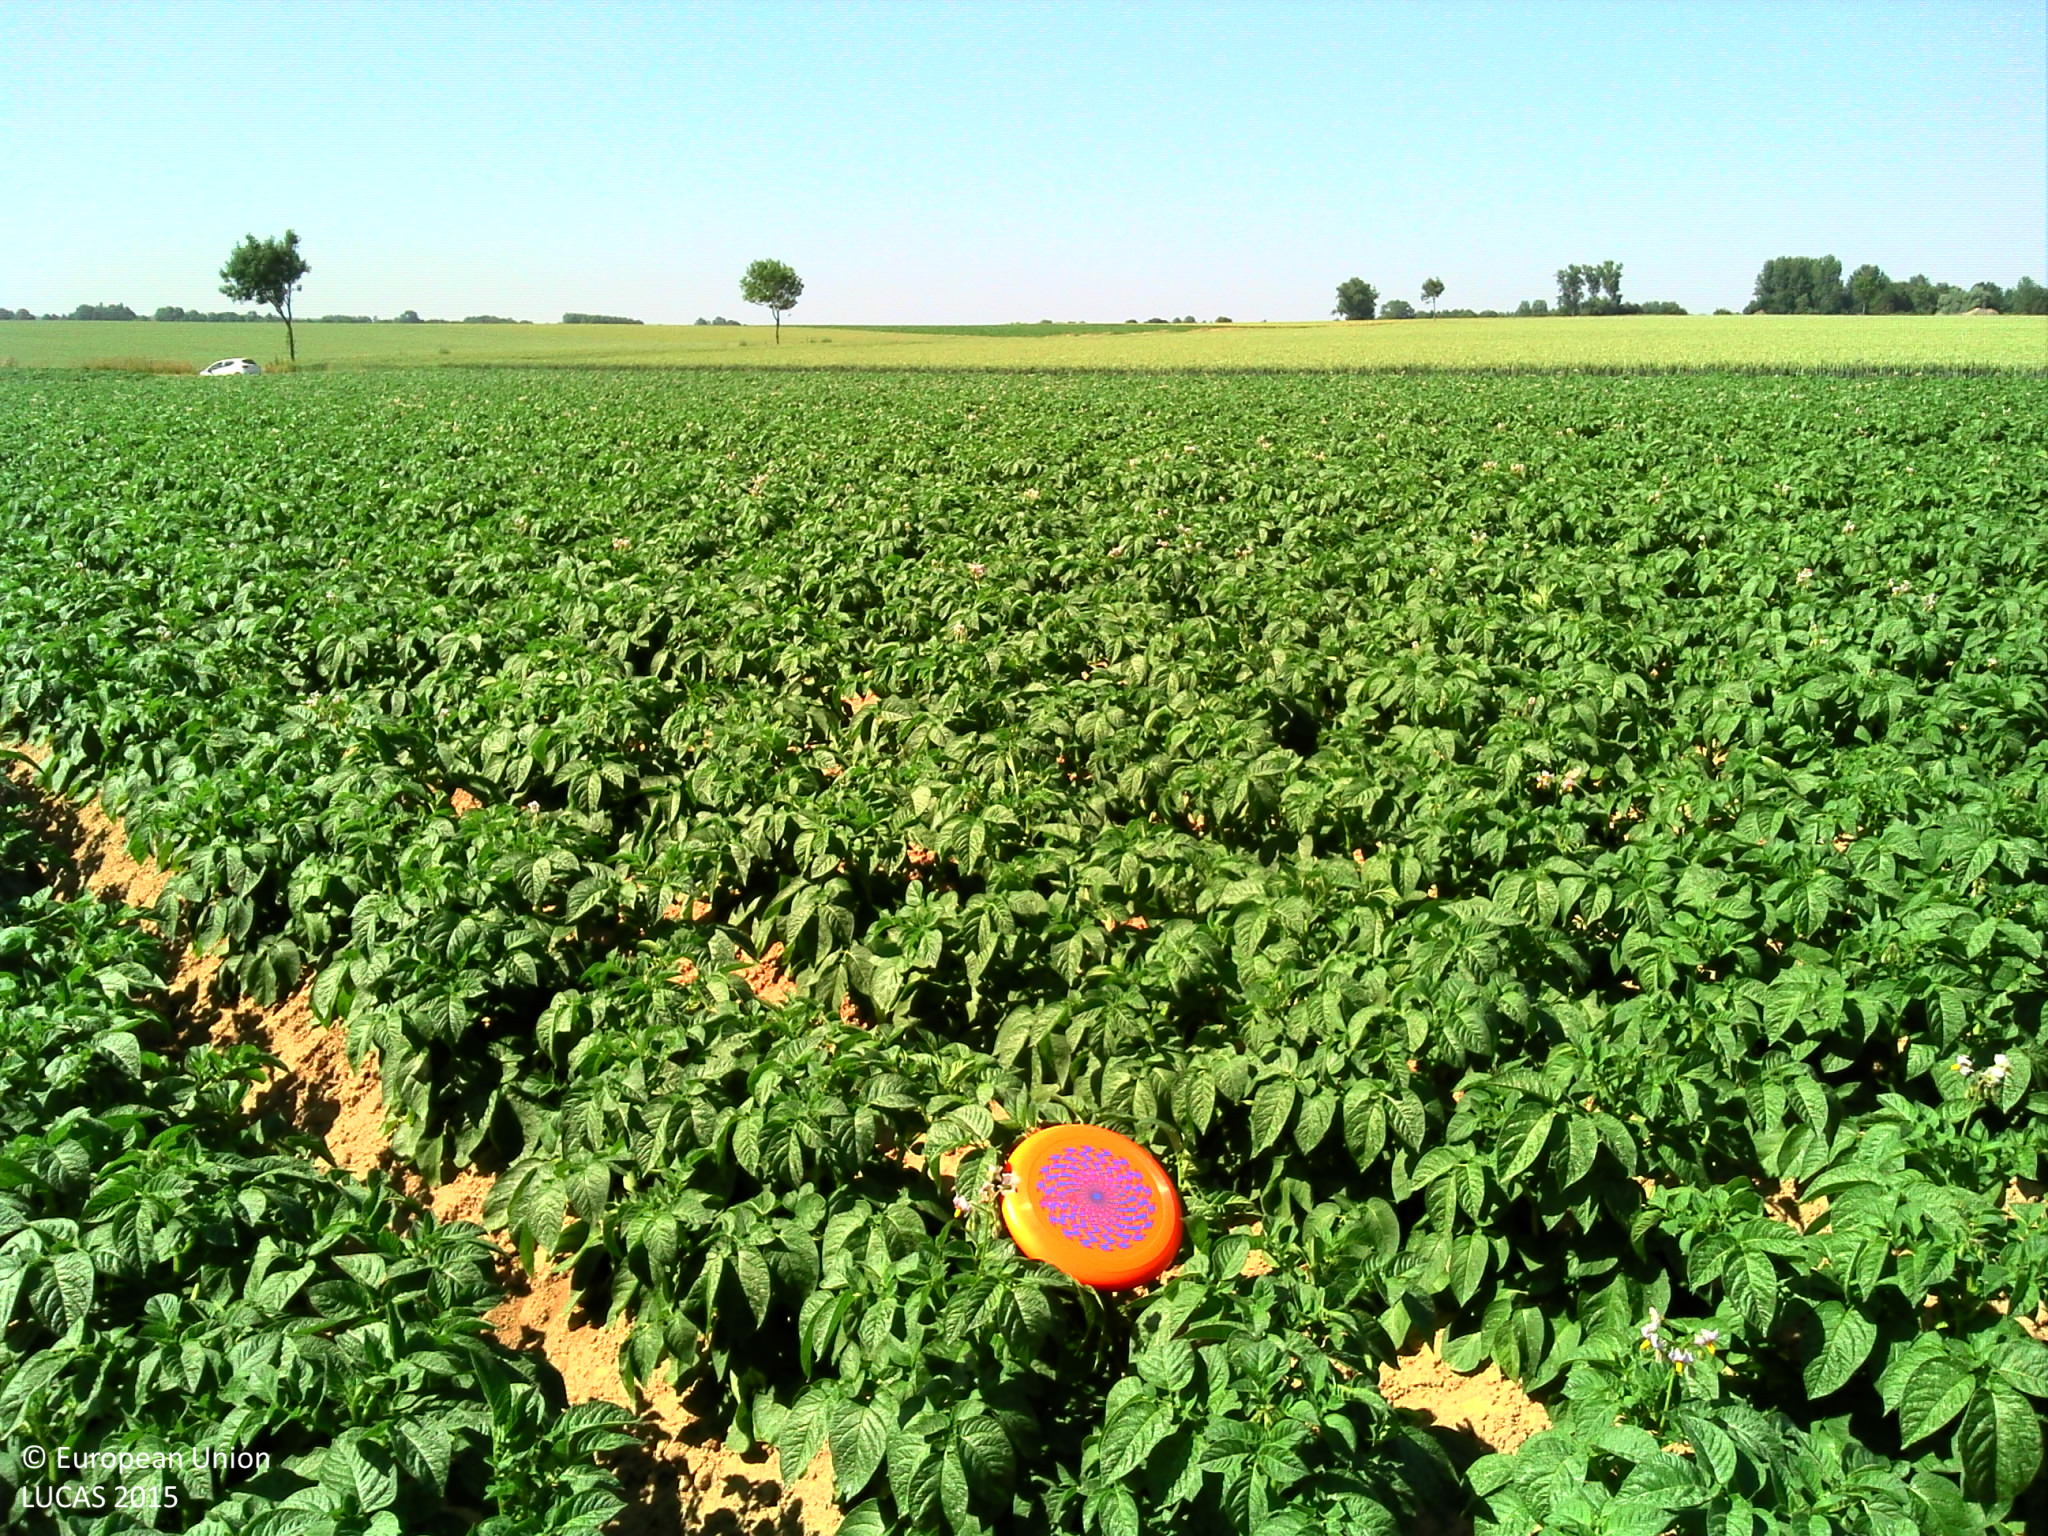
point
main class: Cropland
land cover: Potatoes
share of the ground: > 75 %
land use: Agriculture (excluding fallow land and kitchen gardens)
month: June
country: FR
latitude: 50.3343
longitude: 2.4992
